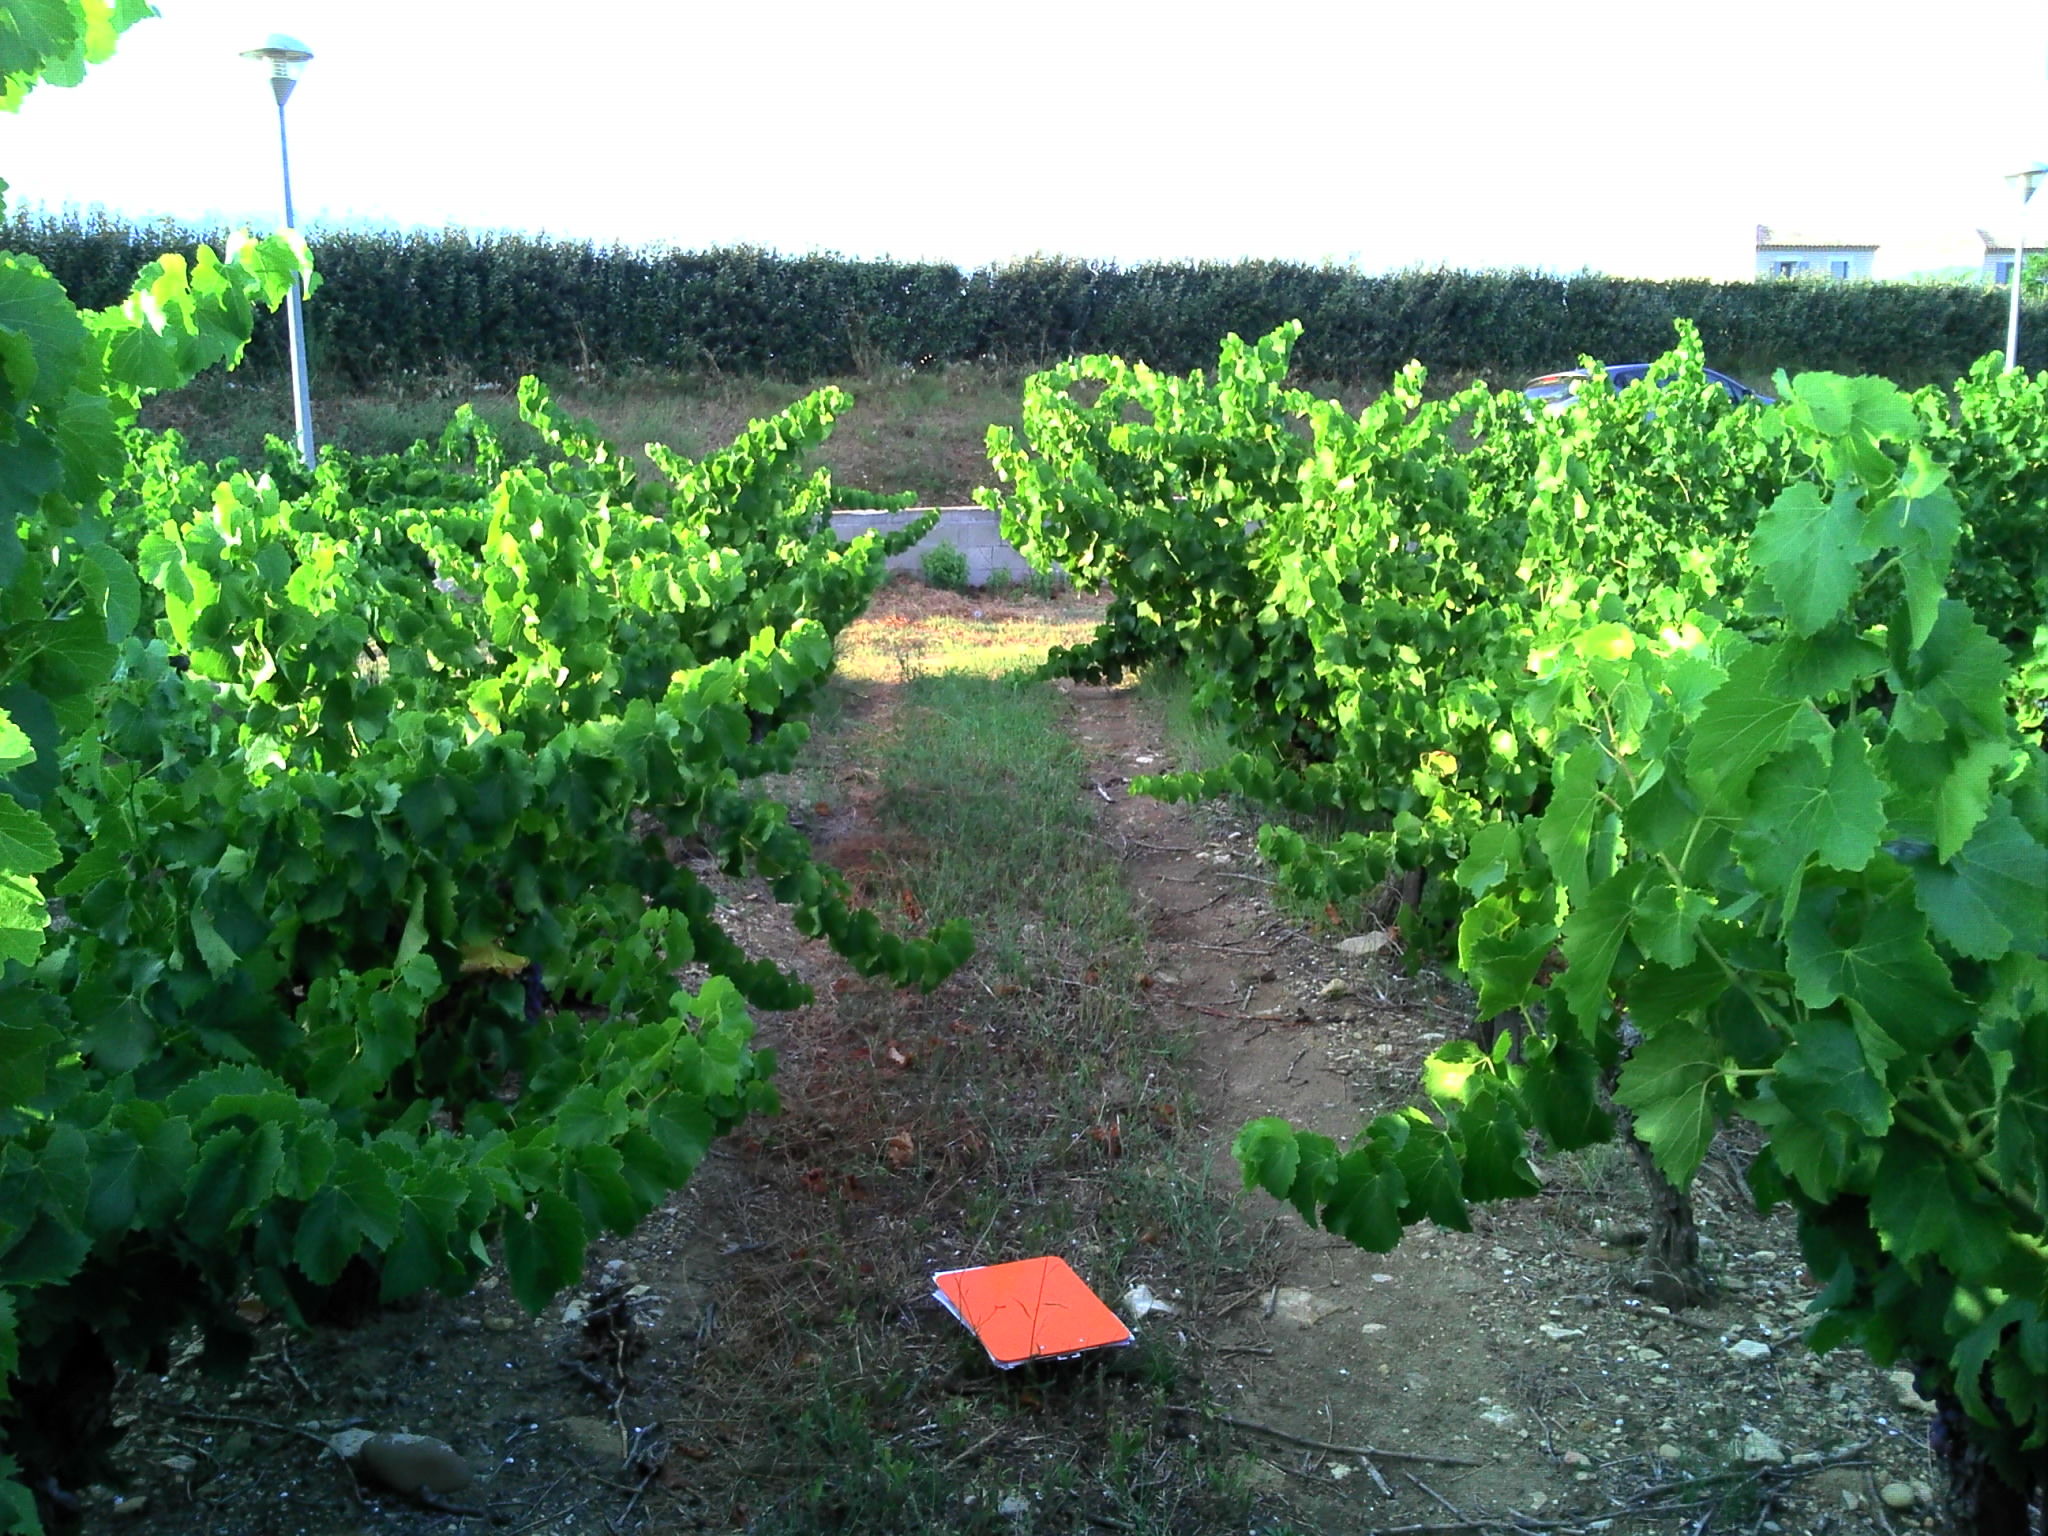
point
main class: Cropland
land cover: Vineyards
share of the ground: 50 - 75 %
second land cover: Spontaneously vegetated surfaces
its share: 25 - 50 %
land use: Agriculture (excluding fallow land and kitchen gardens)
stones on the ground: < 10 %
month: August
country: FR
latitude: 44.2300
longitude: 4.6368
